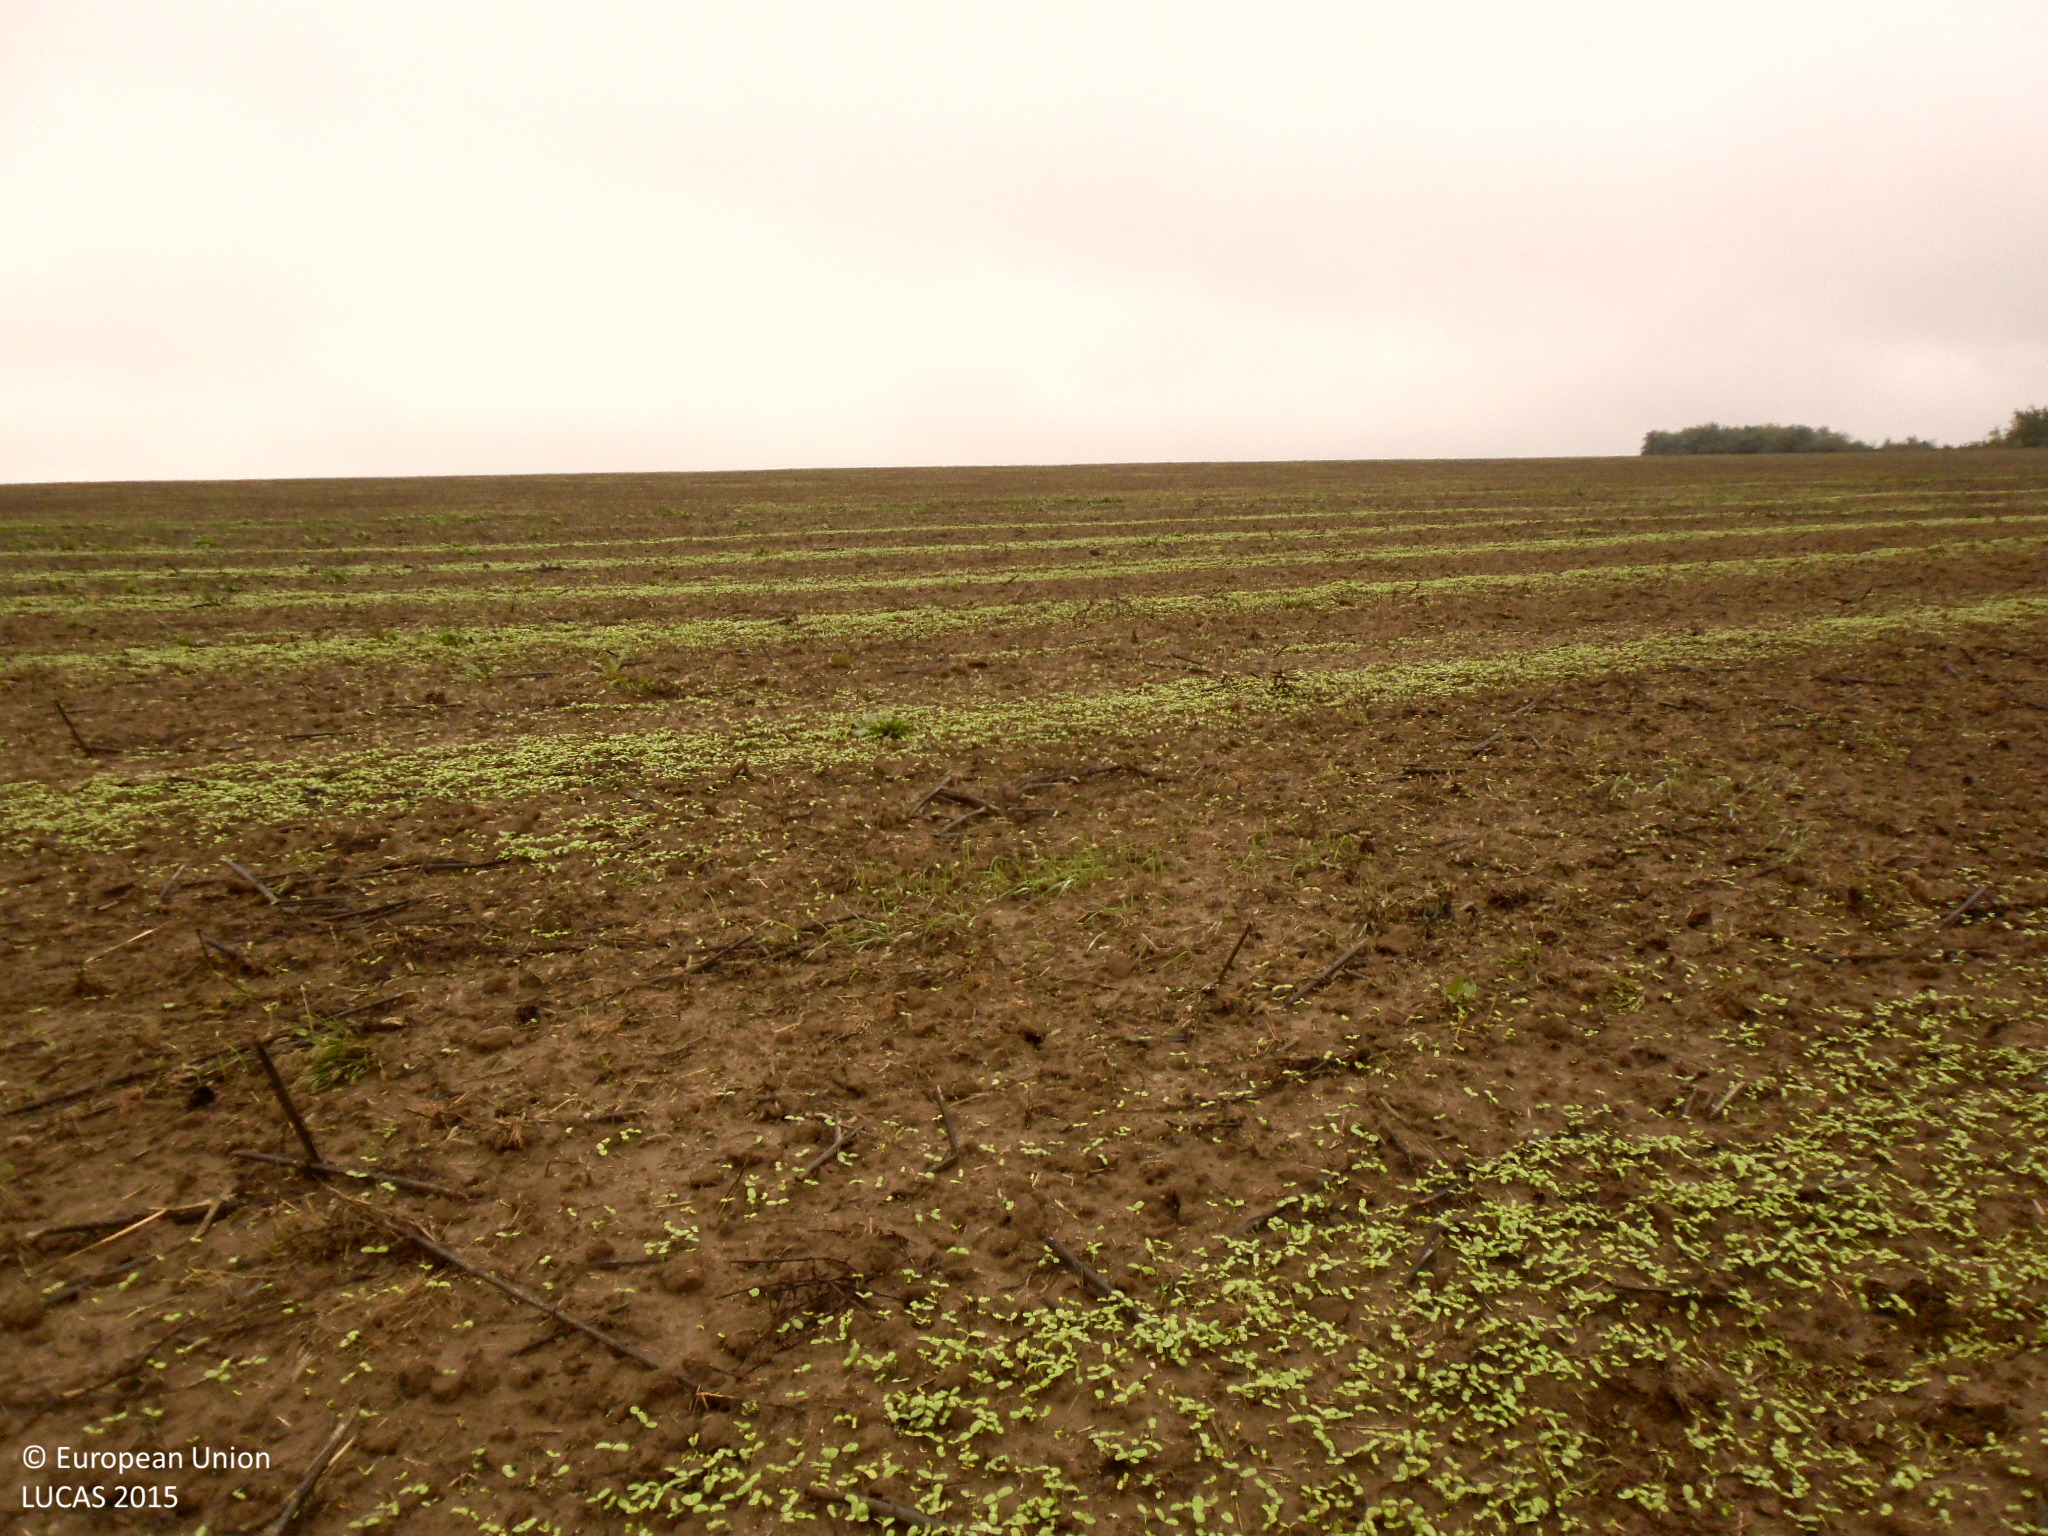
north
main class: Cropland
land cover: Sunflower
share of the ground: < 10 %
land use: Agriculture (excluding fallow land and kitchen gardens)
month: October
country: BG
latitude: 43.9608
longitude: 22.6105
